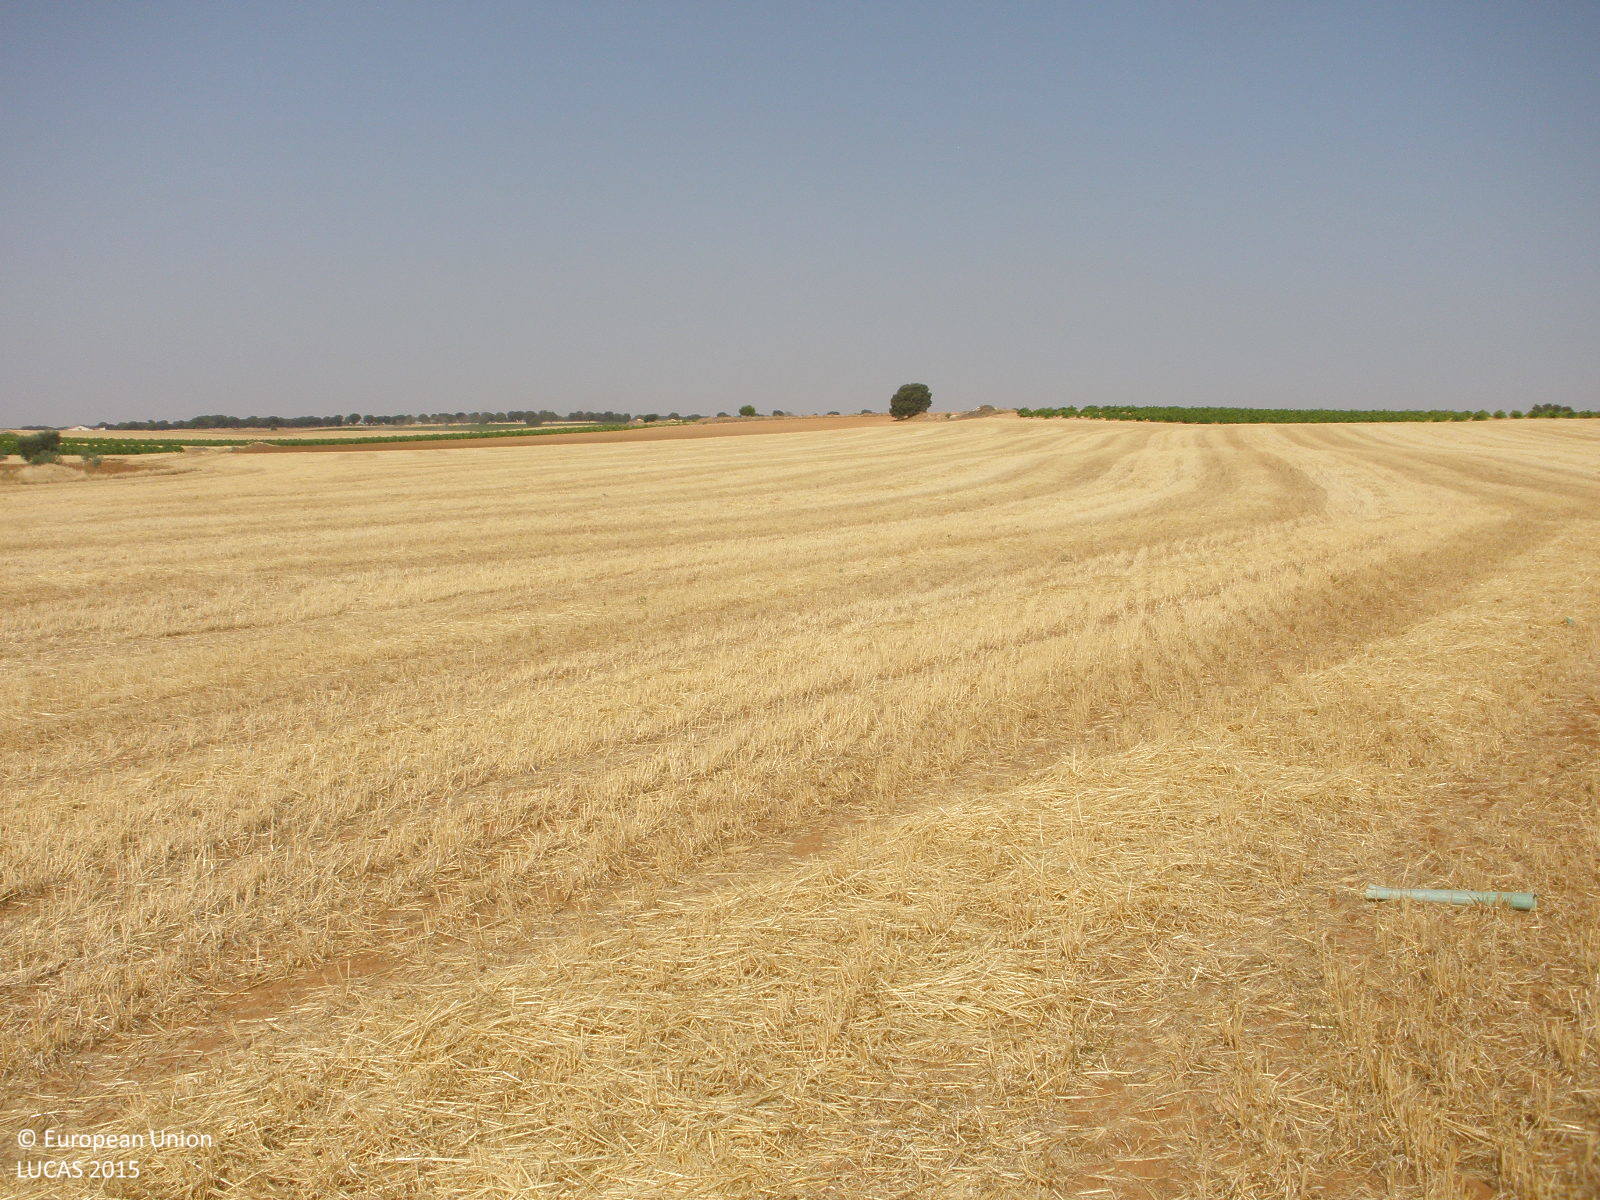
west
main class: Cropland
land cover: Barley
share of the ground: < 10 %
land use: Agriculture (excluding fallow land and kitchen gardens)
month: July
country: ES
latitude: 39.9305
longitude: -3.2599
